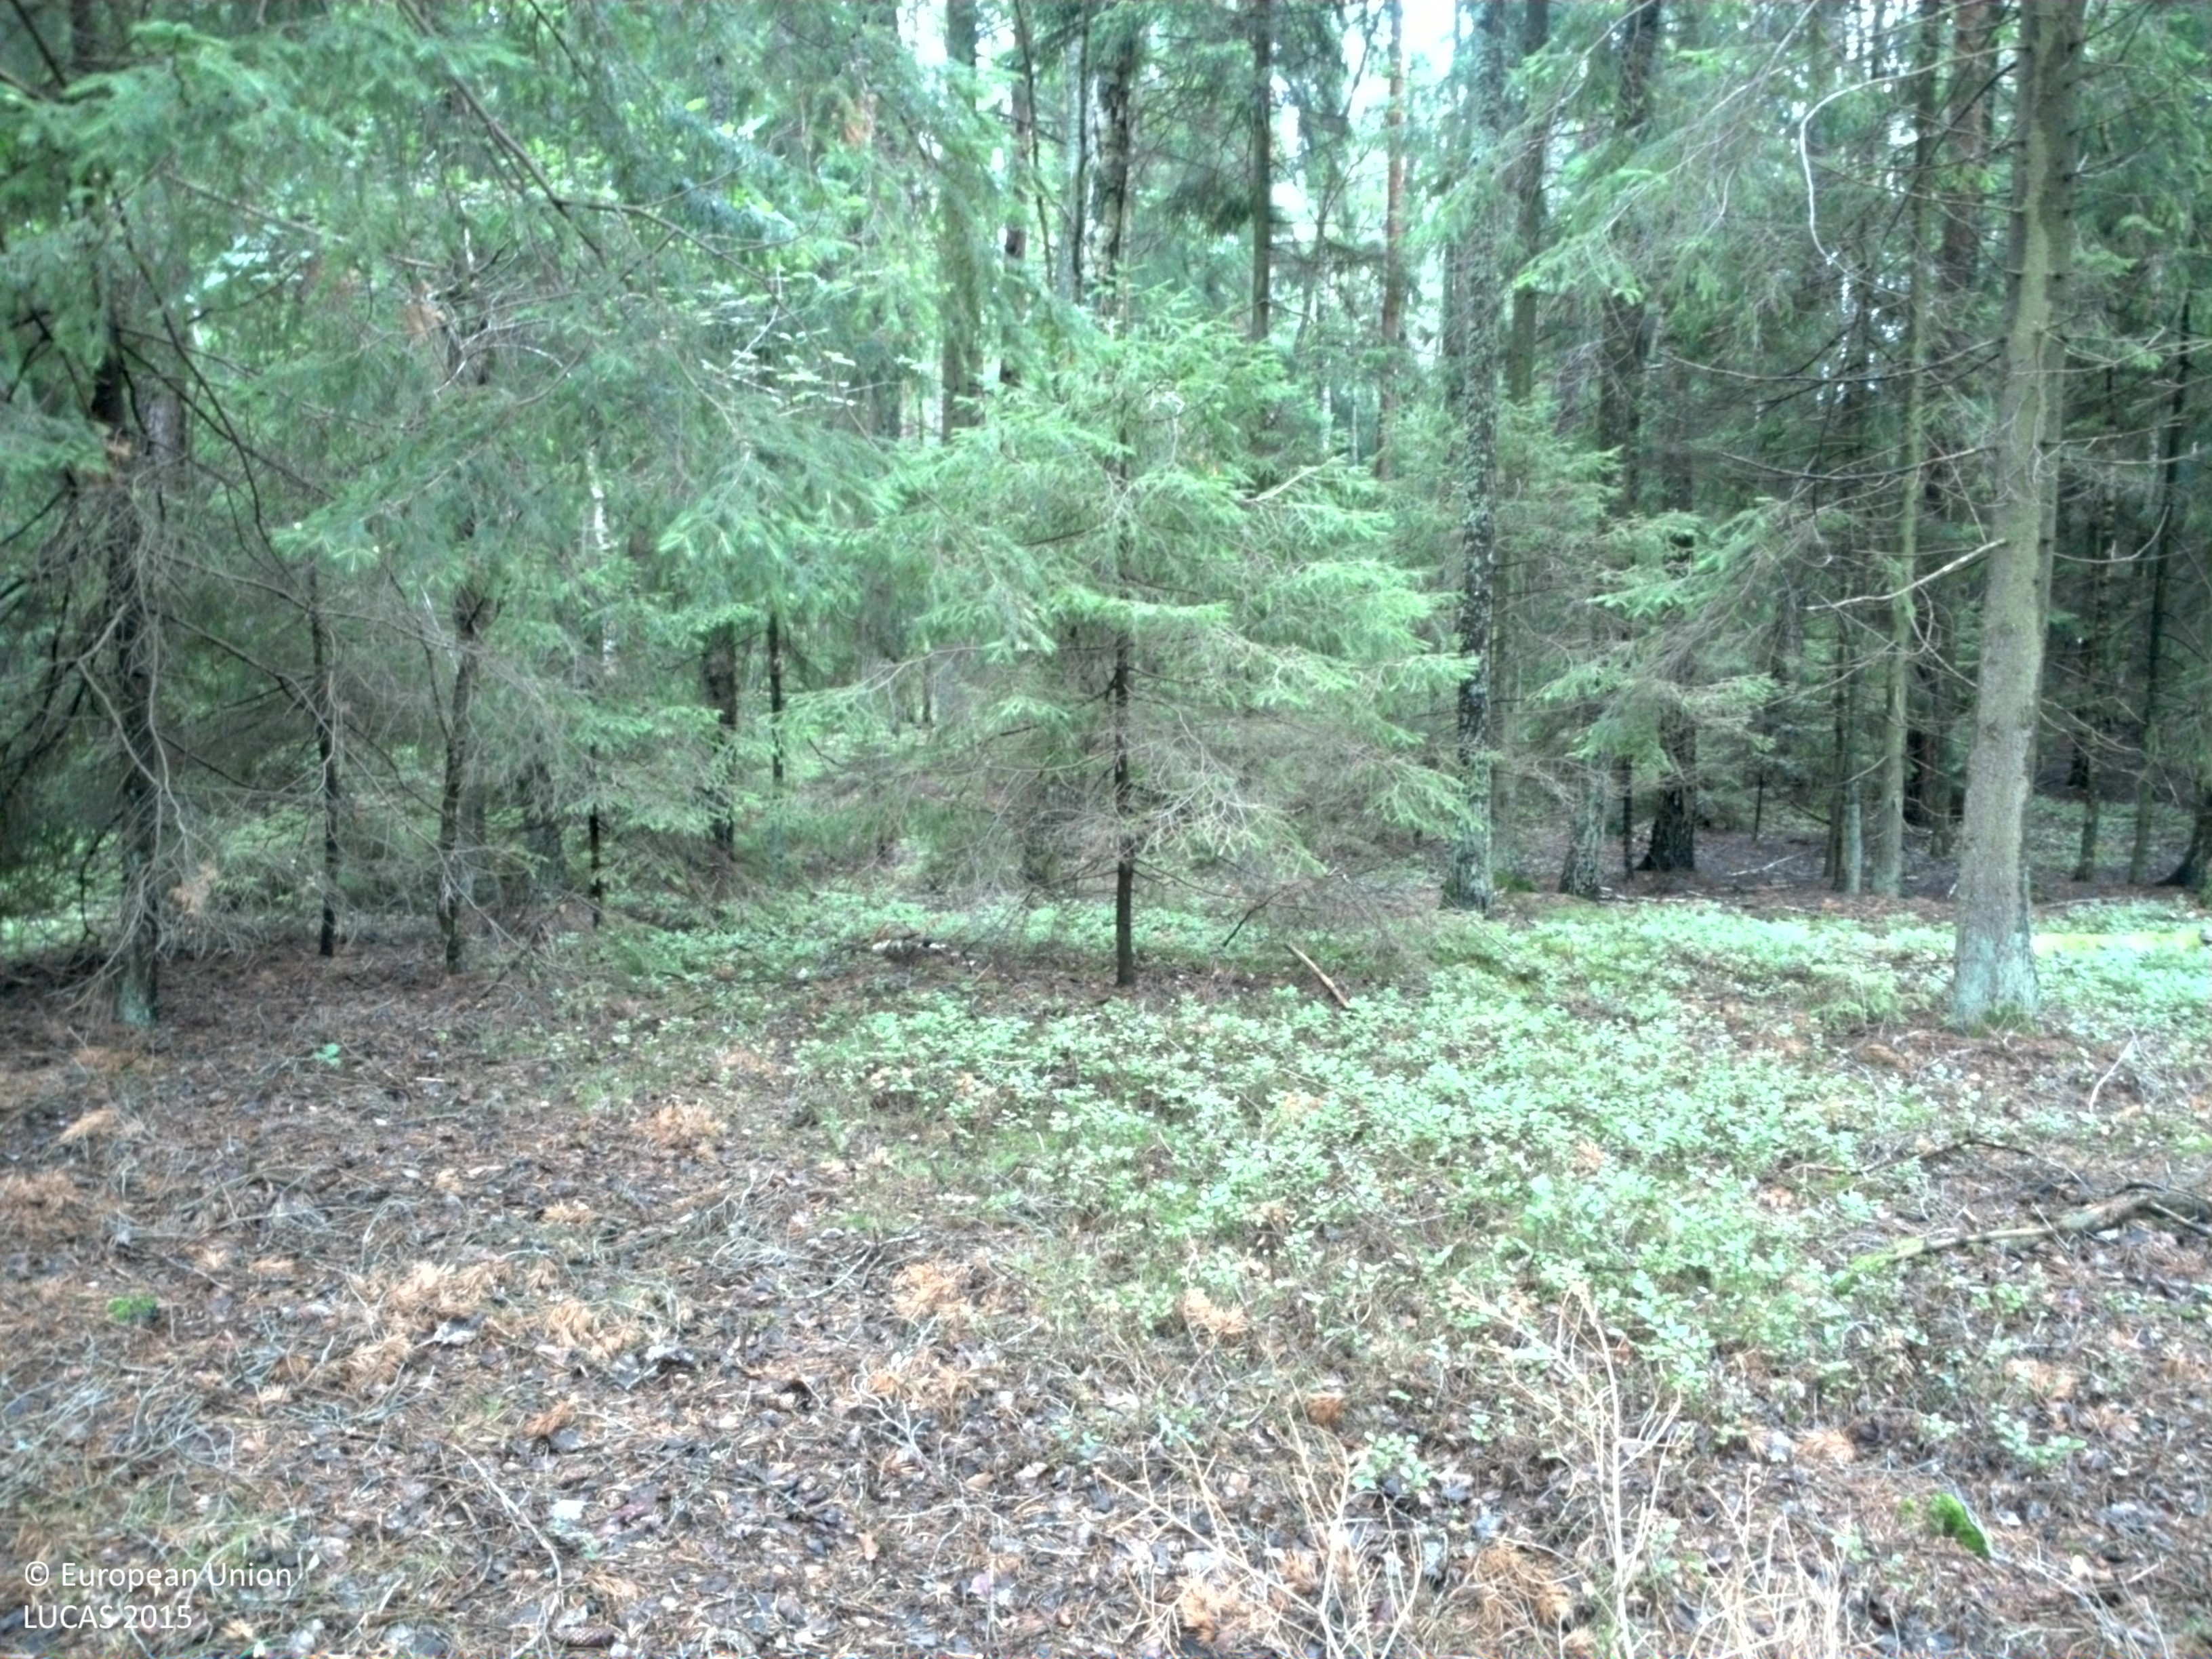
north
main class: Woodland
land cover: Spruce dominated coniferous woodland
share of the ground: > 75 %
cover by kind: coniferous forest trees 75 %, broadleaved forest trees 5 %, shrubs 5 %, herbaceous plants 5 %, lichens and mosses 5 %, unconsolidated bare surface 5 %
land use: Forestry
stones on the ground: < 10 %
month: July
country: SE
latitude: 58.4114
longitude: 13.3660
